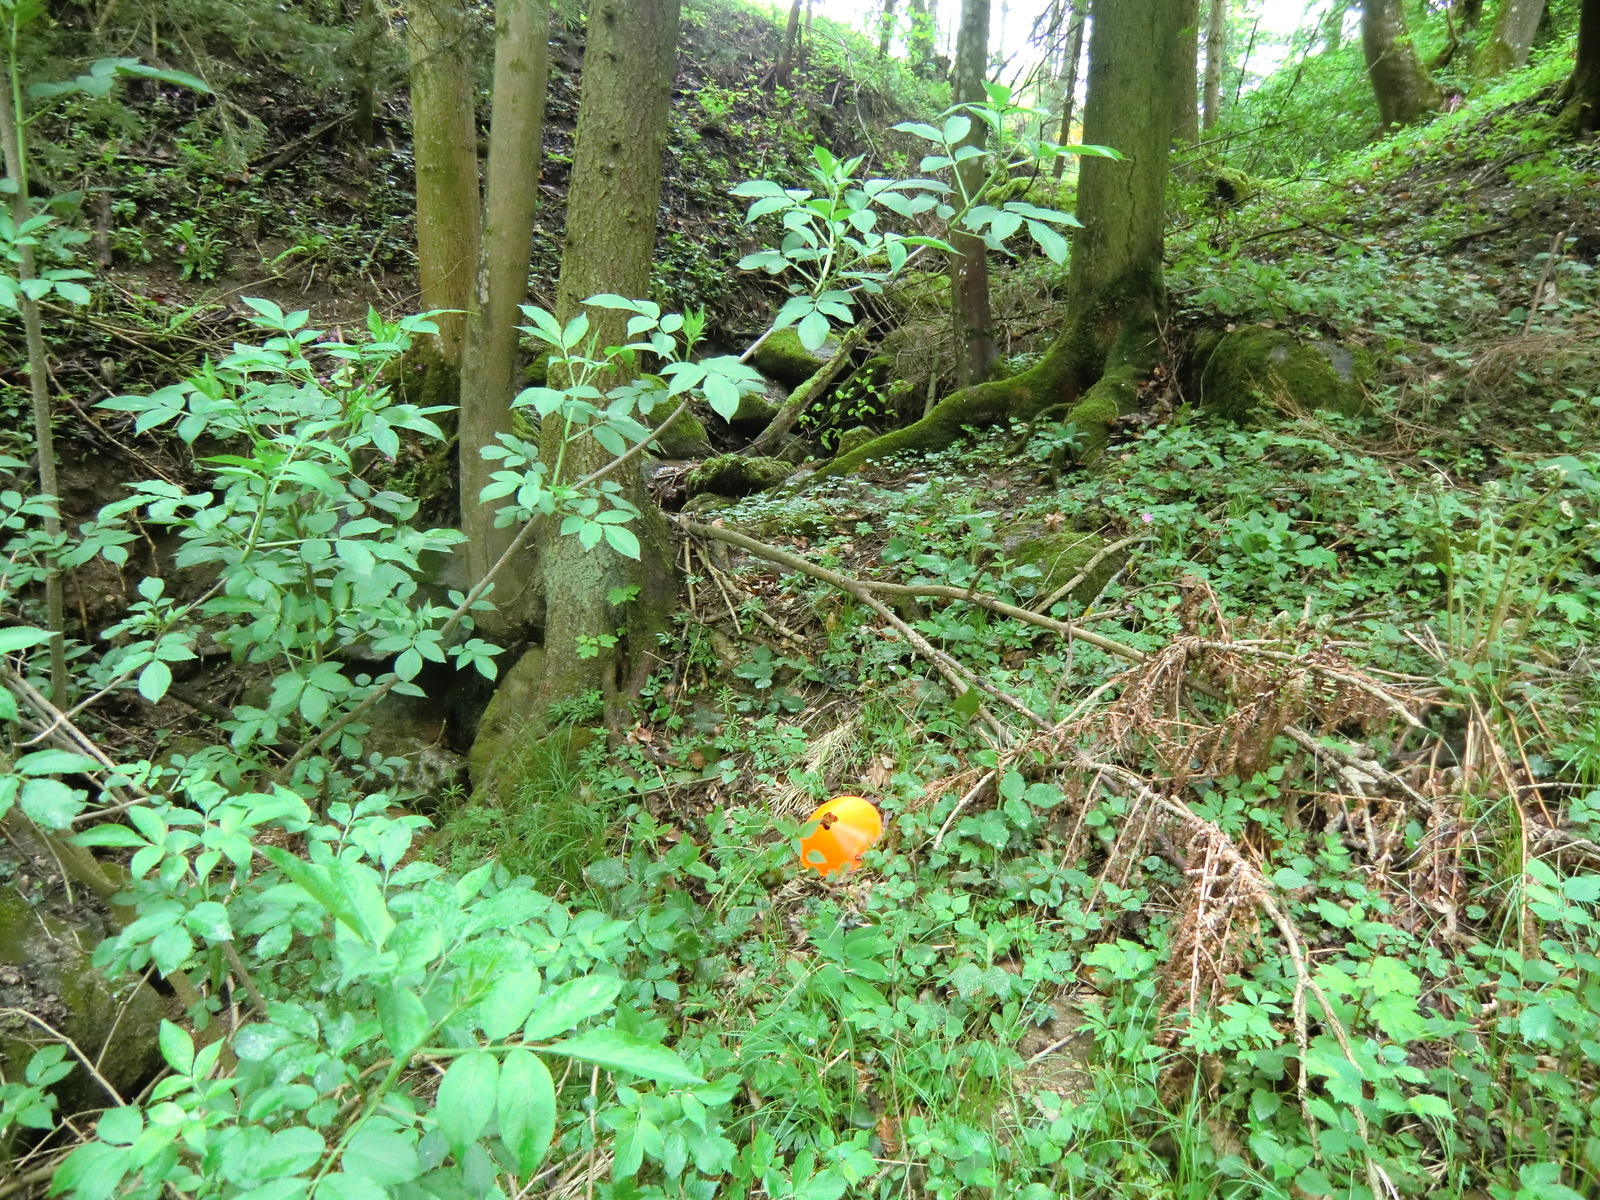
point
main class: Woodland
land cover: Spruce dominated mixed woodland
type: mountainous beech forest
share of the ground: 50 - 75 %
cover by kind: coniferous forest trees 35 %, broadleaved forest trees 35 %, shrubs 15 %, herbaceous plants 15 %
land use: Forestry
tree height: > 5 m
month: May
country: AT
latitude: 48.2831
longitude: 14.7580
